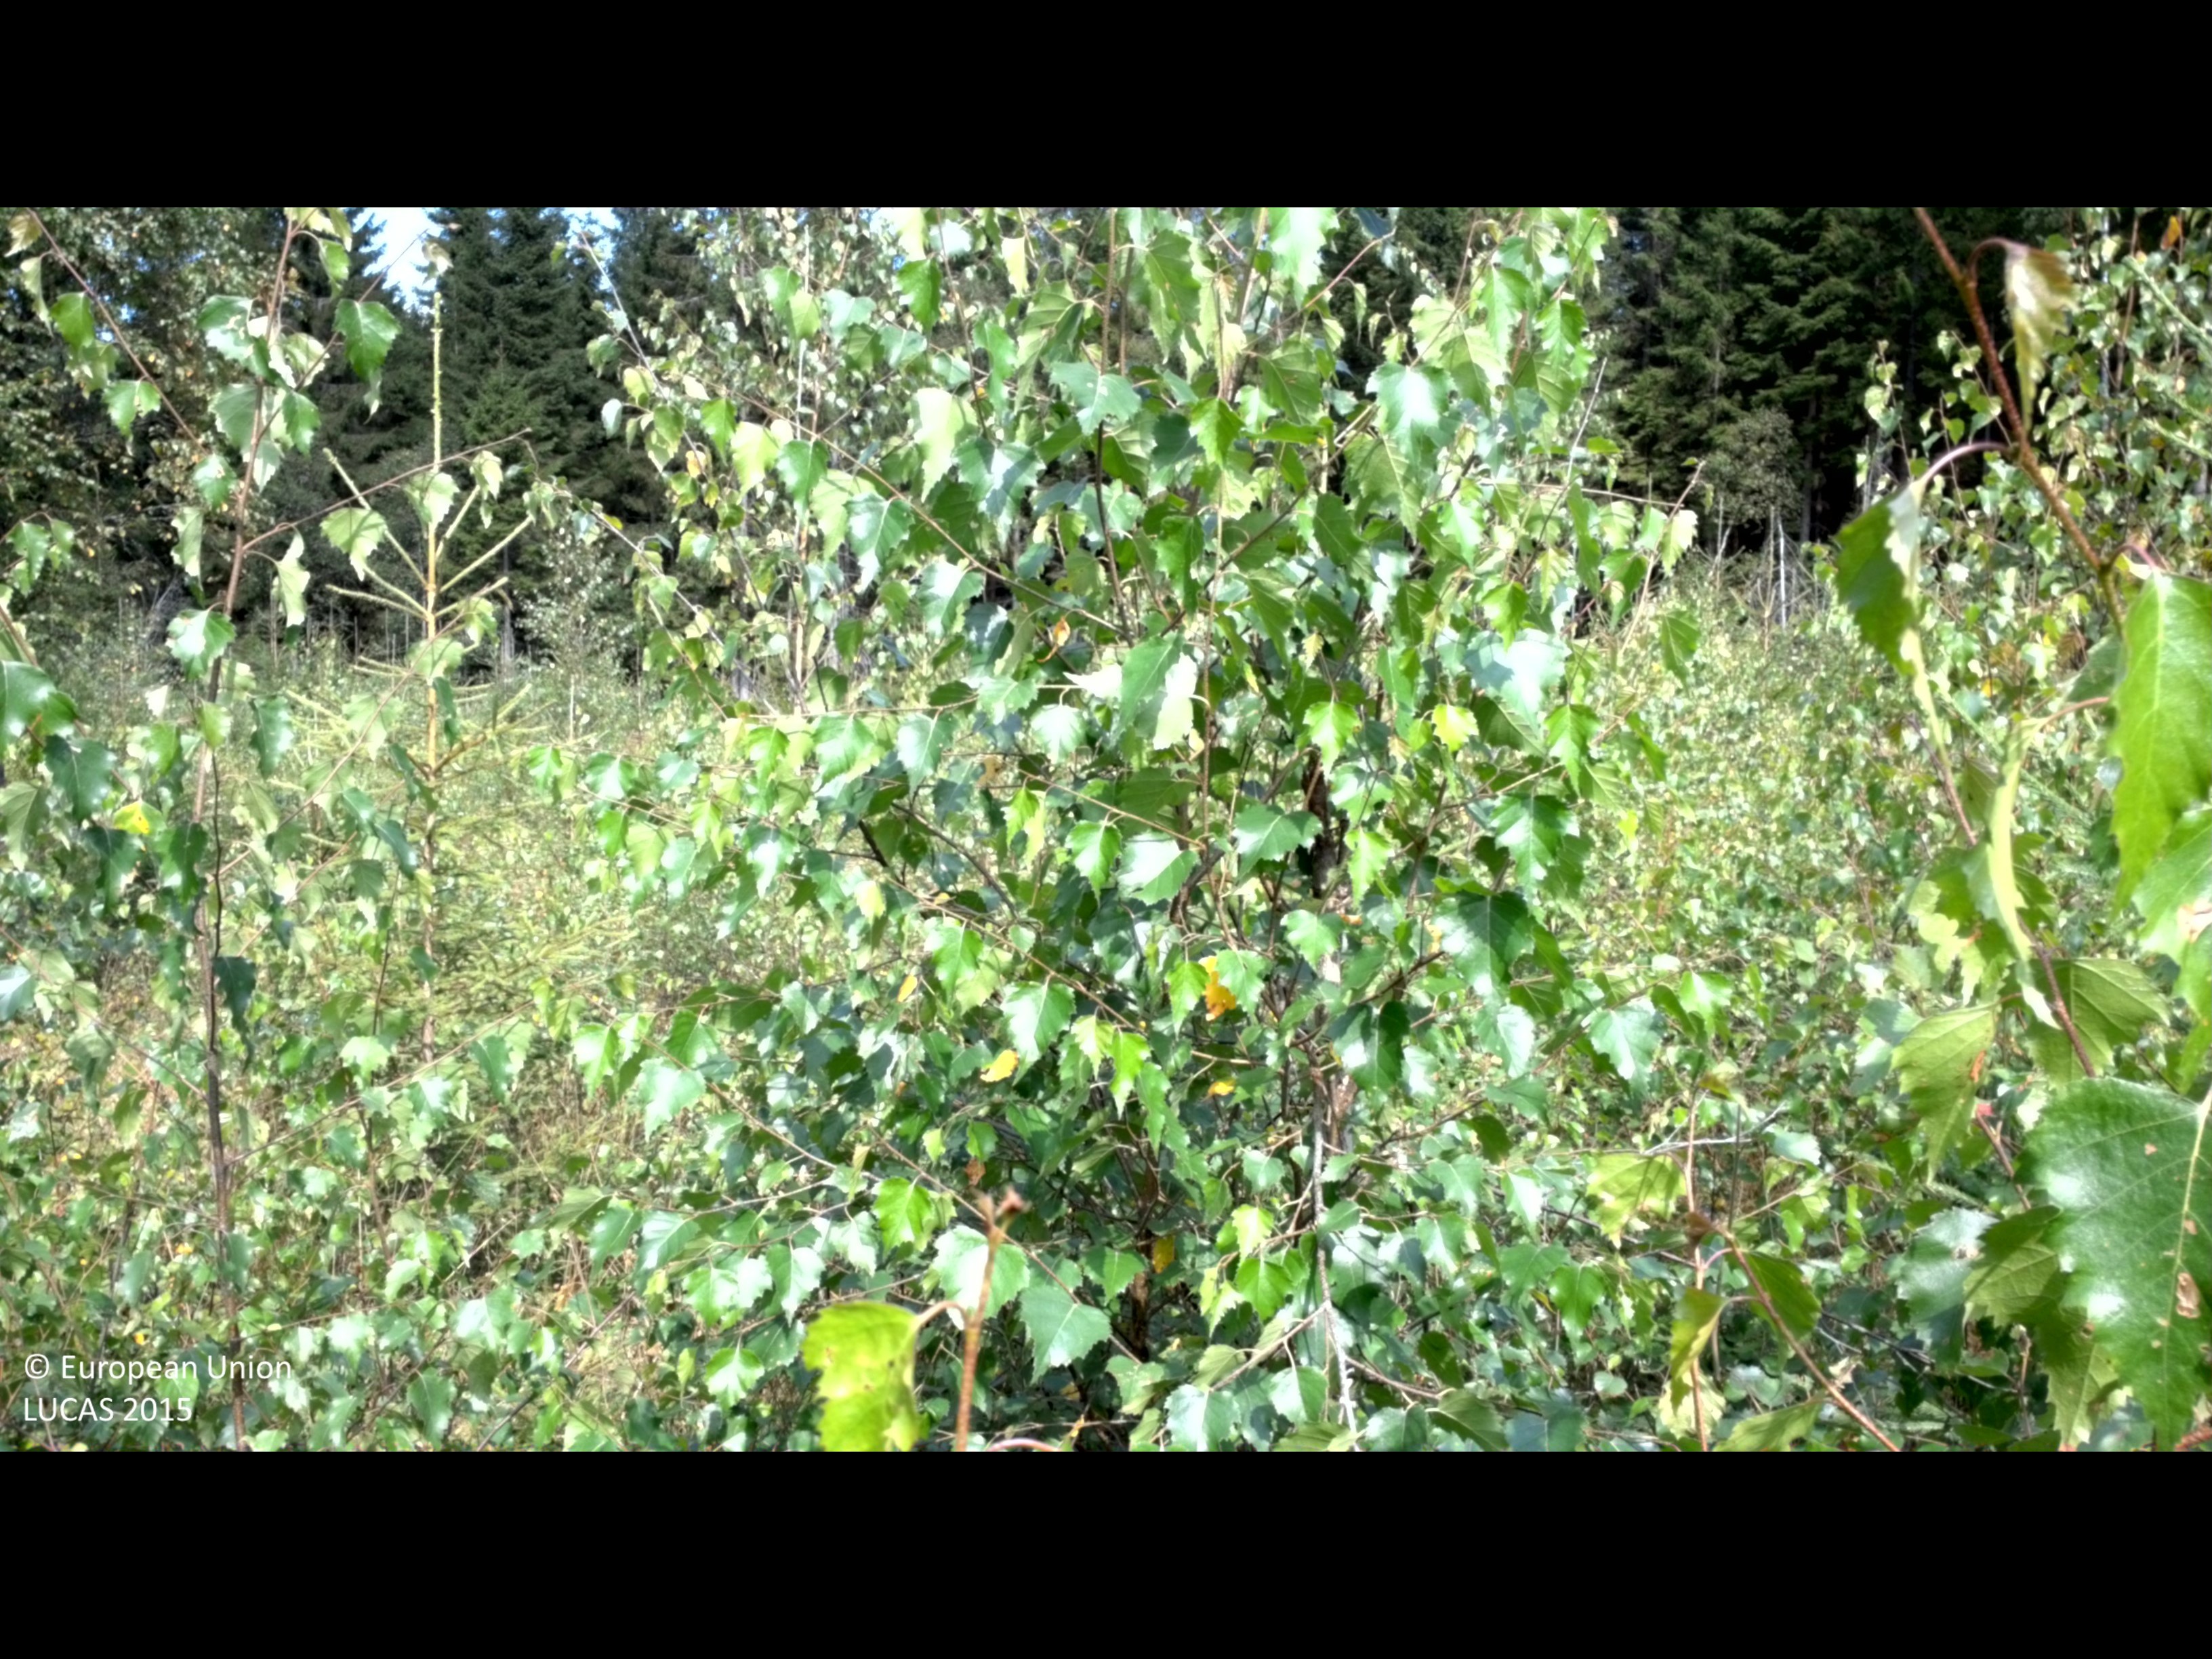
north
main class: Woodland
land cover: Spruce dominated mixed woodland
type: boreal forest
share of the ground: > 75 %
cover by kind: broadleaved forest trees 45 %, coniferous forest trees 30 %, herbaceous plants 20 %, shrubs 5 %
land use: Forestry
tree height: < 5 m
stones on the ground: < 10 %
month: August
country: SE
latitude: 56.8520
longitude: 13.7844
